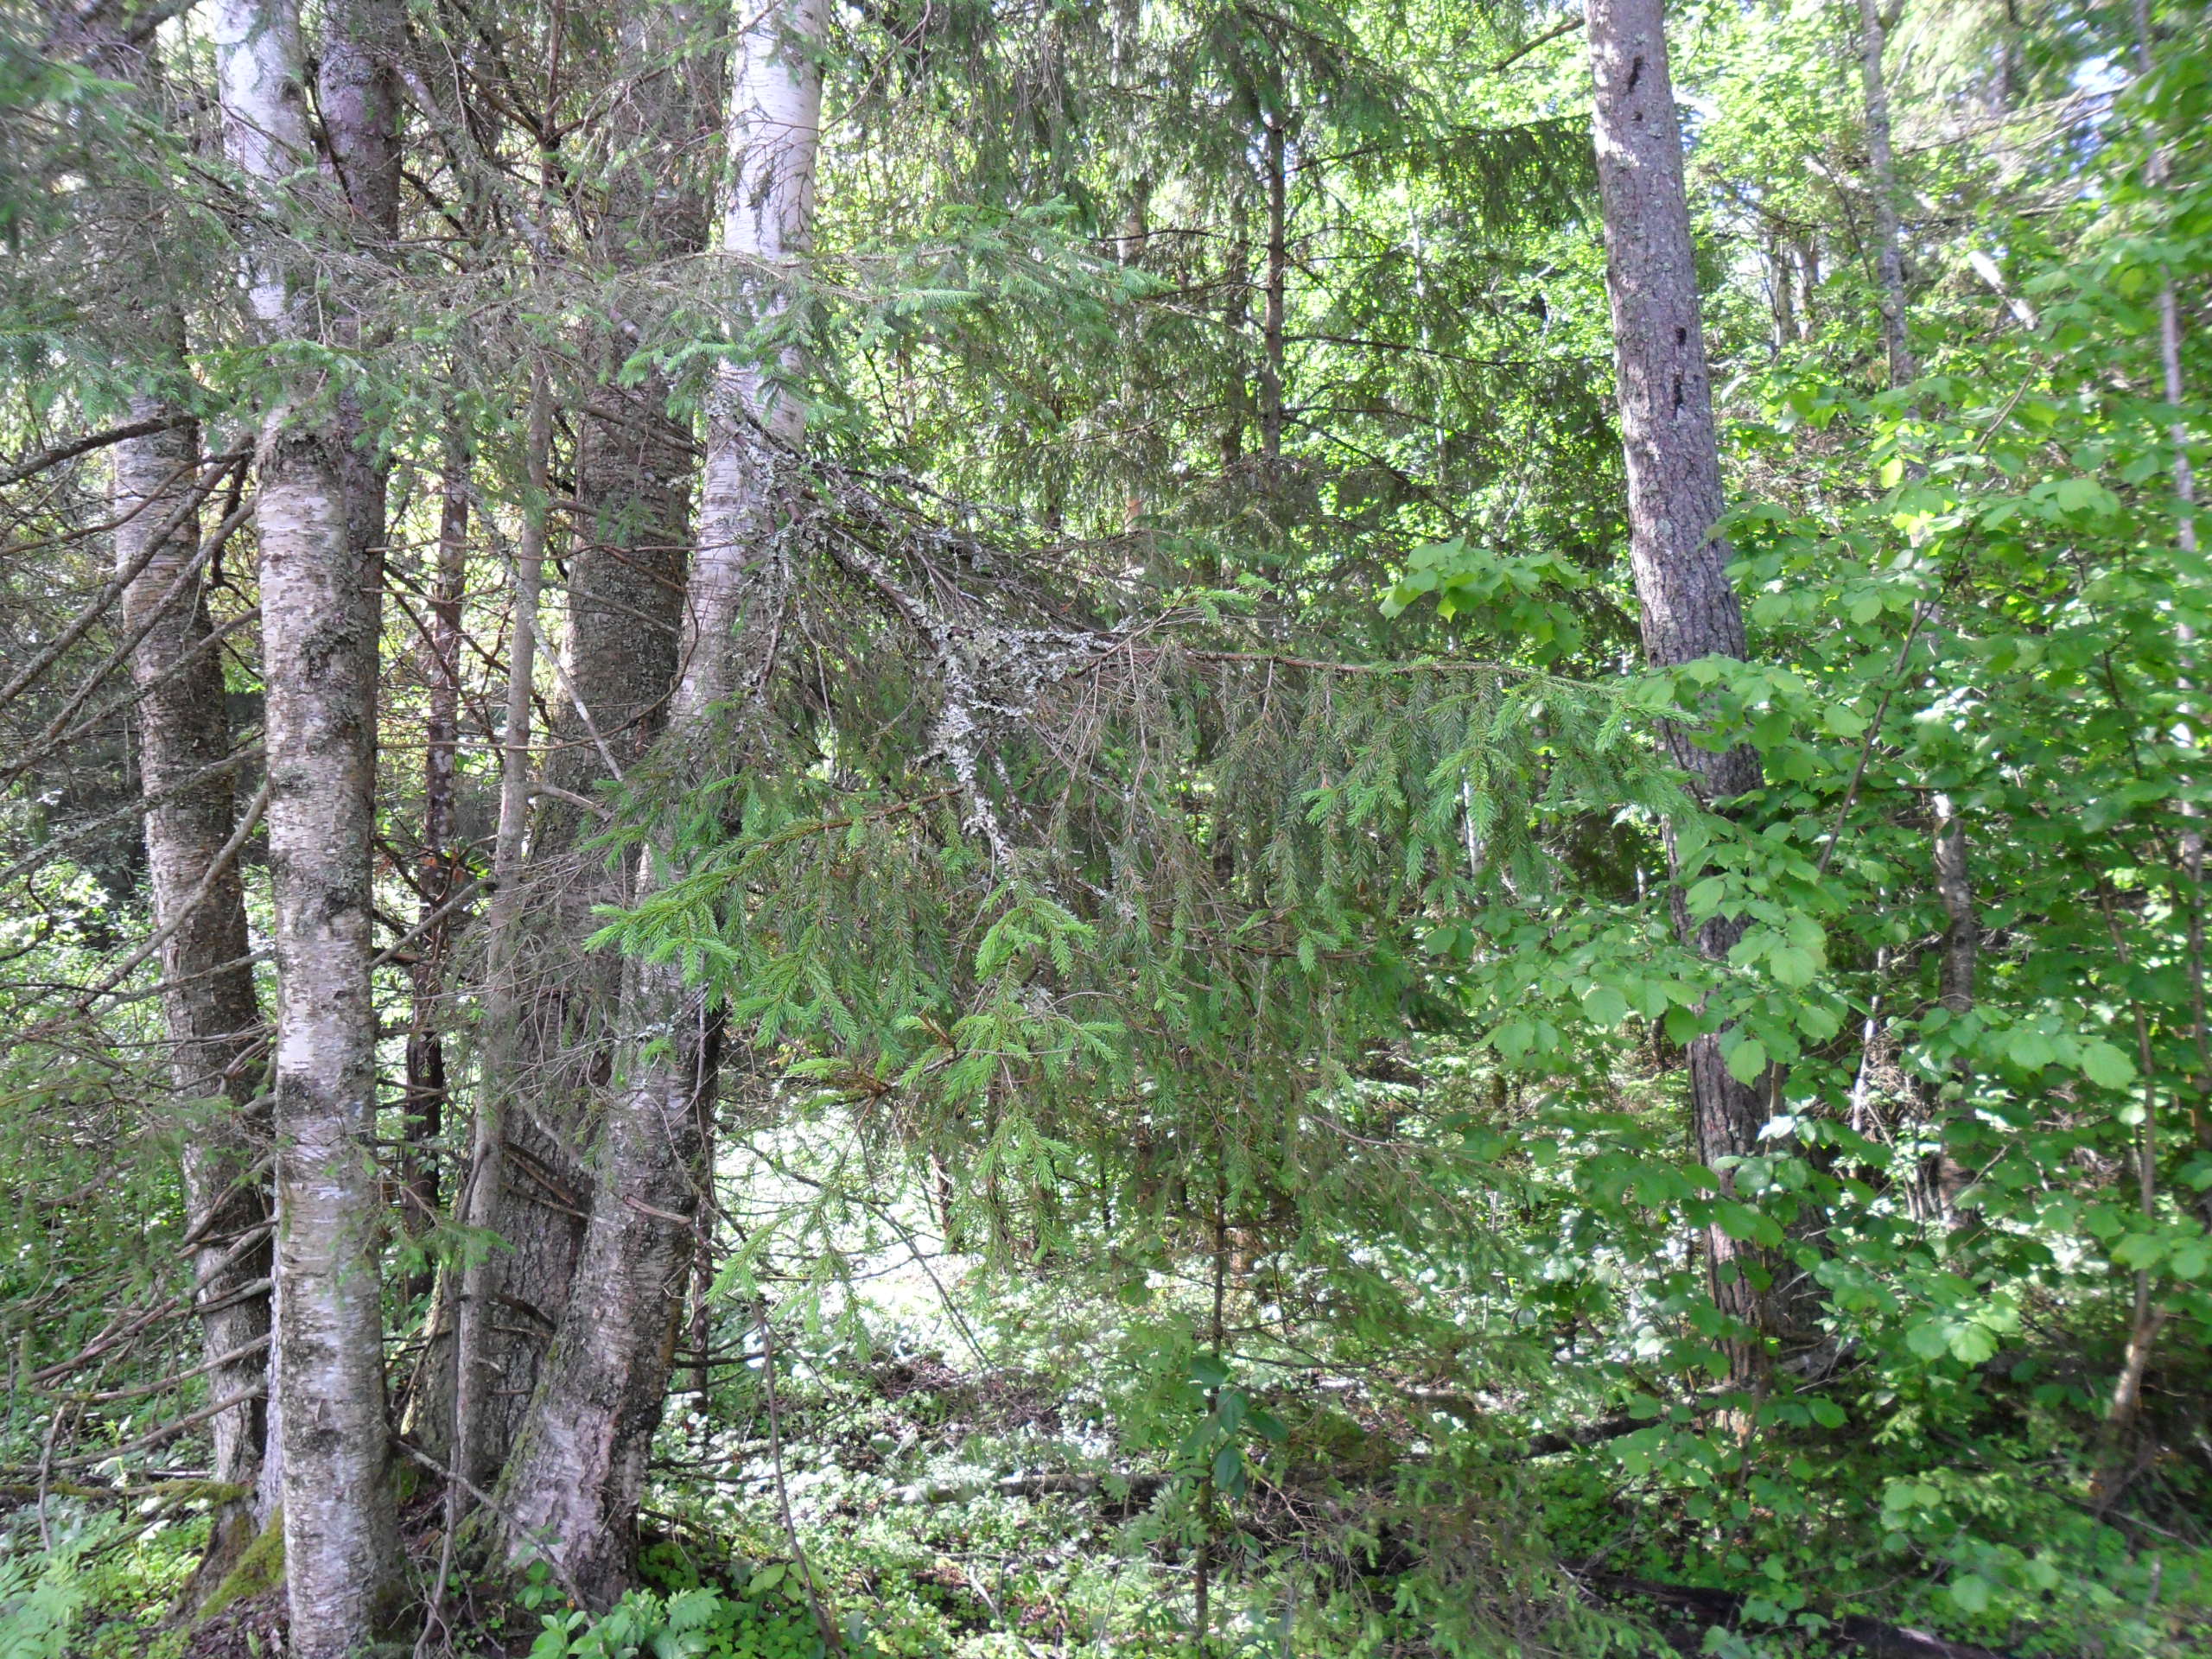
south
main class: Woodland
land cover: Spruce dominated mixed woodland
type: hemiboreal forest and nemoral coniferous forest and mixed broadleaved-coniferous forest
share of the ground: 50 - 75 %
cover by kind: broadleaved forest trees 40 %, coniferous forest trees 30 %, shrubs 20 %, herbaceous plants 10 %
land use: Forestry
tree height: > 5 m
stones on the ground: < 10 %
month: June
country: LV
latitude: 57.4051
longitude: 22.0128
